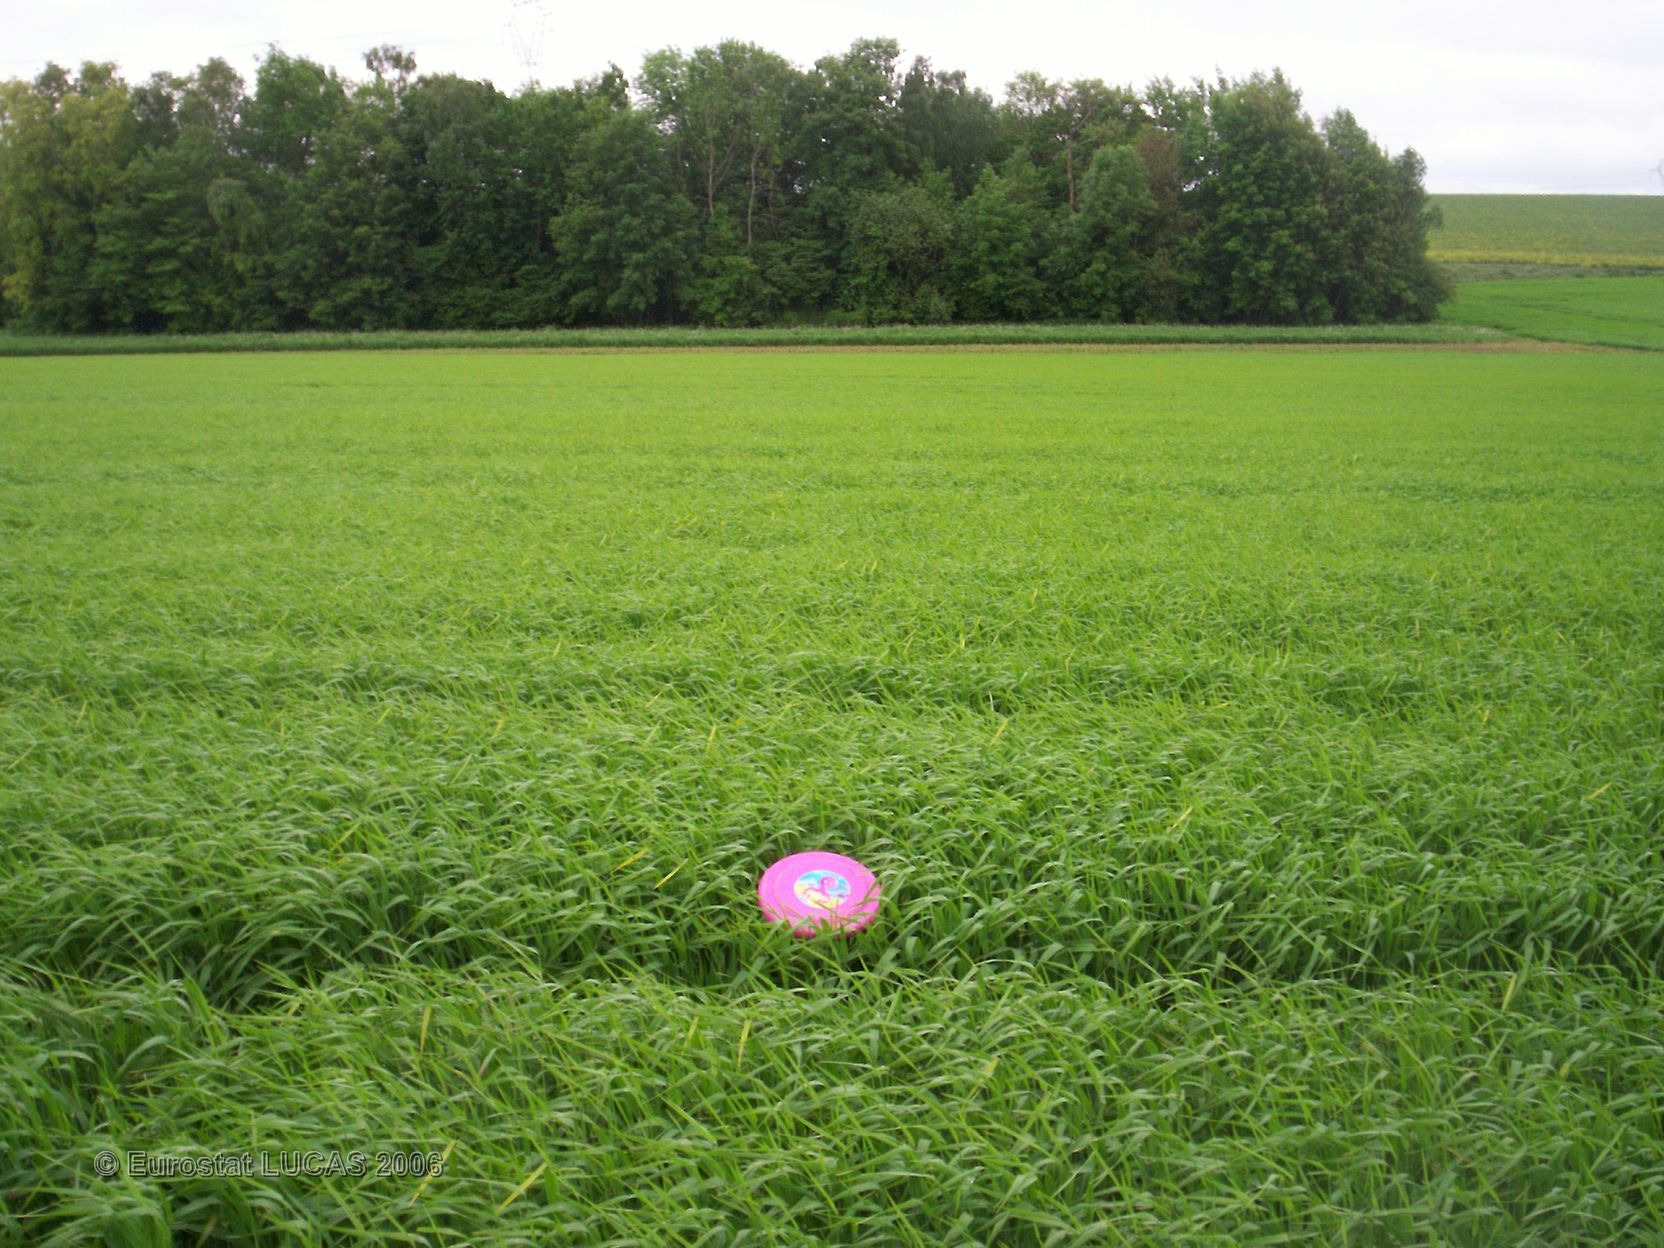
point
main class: Cropland
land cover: Barley
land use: Agriculture (excluding fallow land and kitchen gardens)
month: May
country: FR
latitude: 49.3240
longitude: 4.3688
